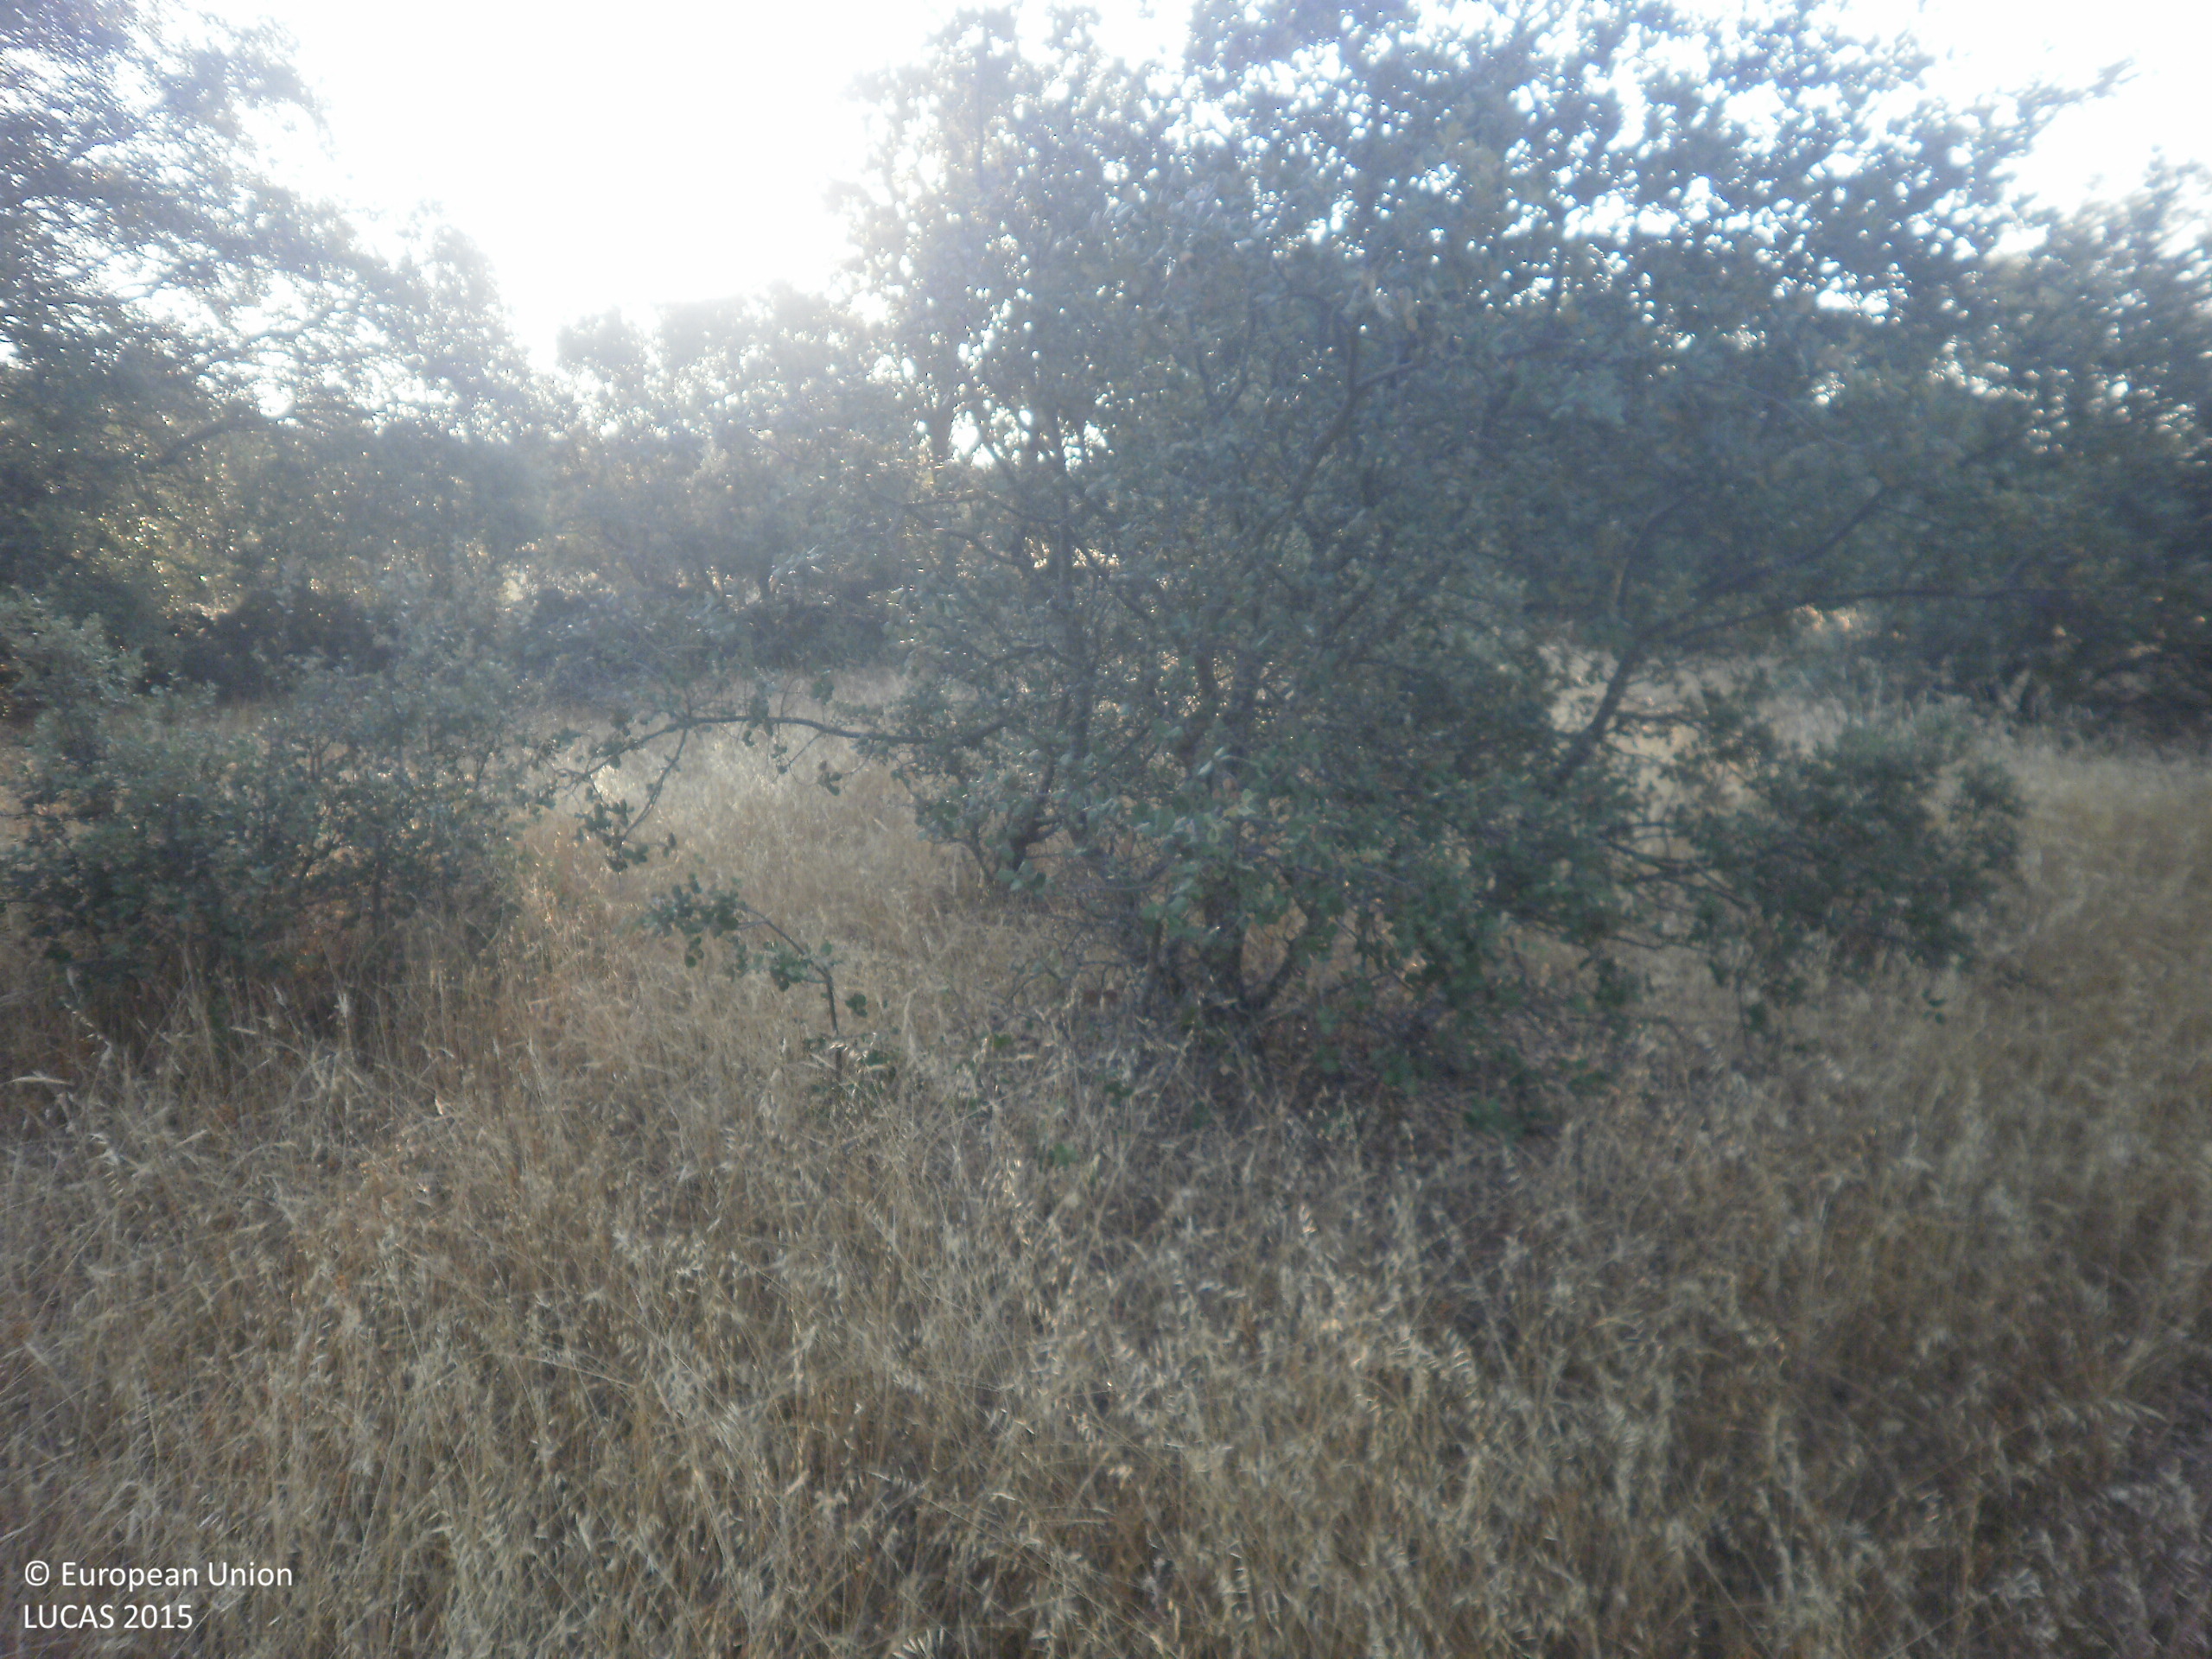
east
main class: Woodland
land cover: Broadleaved woodland
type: broadleaved evergreen forest
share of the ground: 50 - 75 %
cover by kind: shrubs 50 %, broadleaved forest trees 25 %, herbaceous plants 25 %
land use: Semi-natural and natural areas not in use
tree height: > 5 m
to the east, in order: Broadleaved woodland; Dry stone walls; Shrubland with sparse tree cover; Dry stone walls; Olive groves; Dry stone walls; Vineyards; Dry stone walls; Tracks; Dry stone walls; Broadleaved woodland
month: June
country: ES
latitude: 39.2803
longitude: -5.9735
